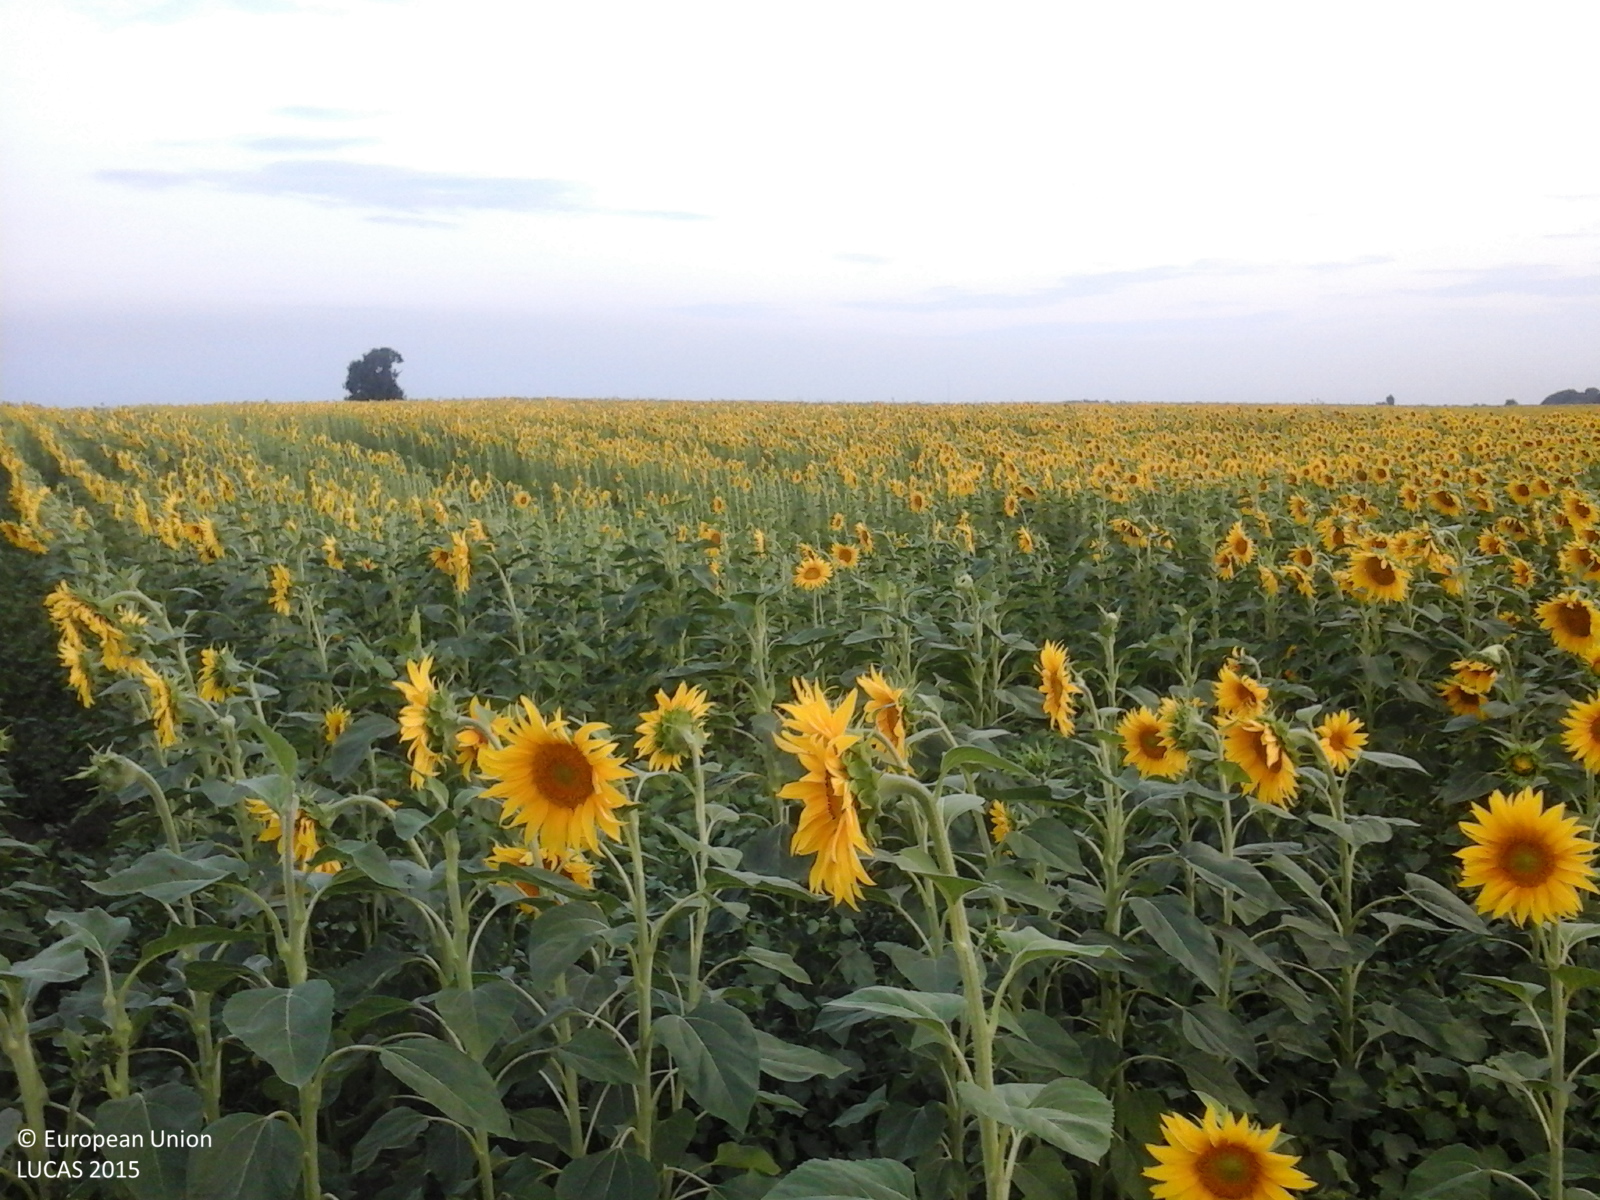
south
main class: Cropland
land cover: Sunflower
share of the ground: > 75 %
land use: Agriculture (excluding fallow land and kitchen gardens)
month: July
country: RO
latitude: 43.9327
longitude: 25.9539
